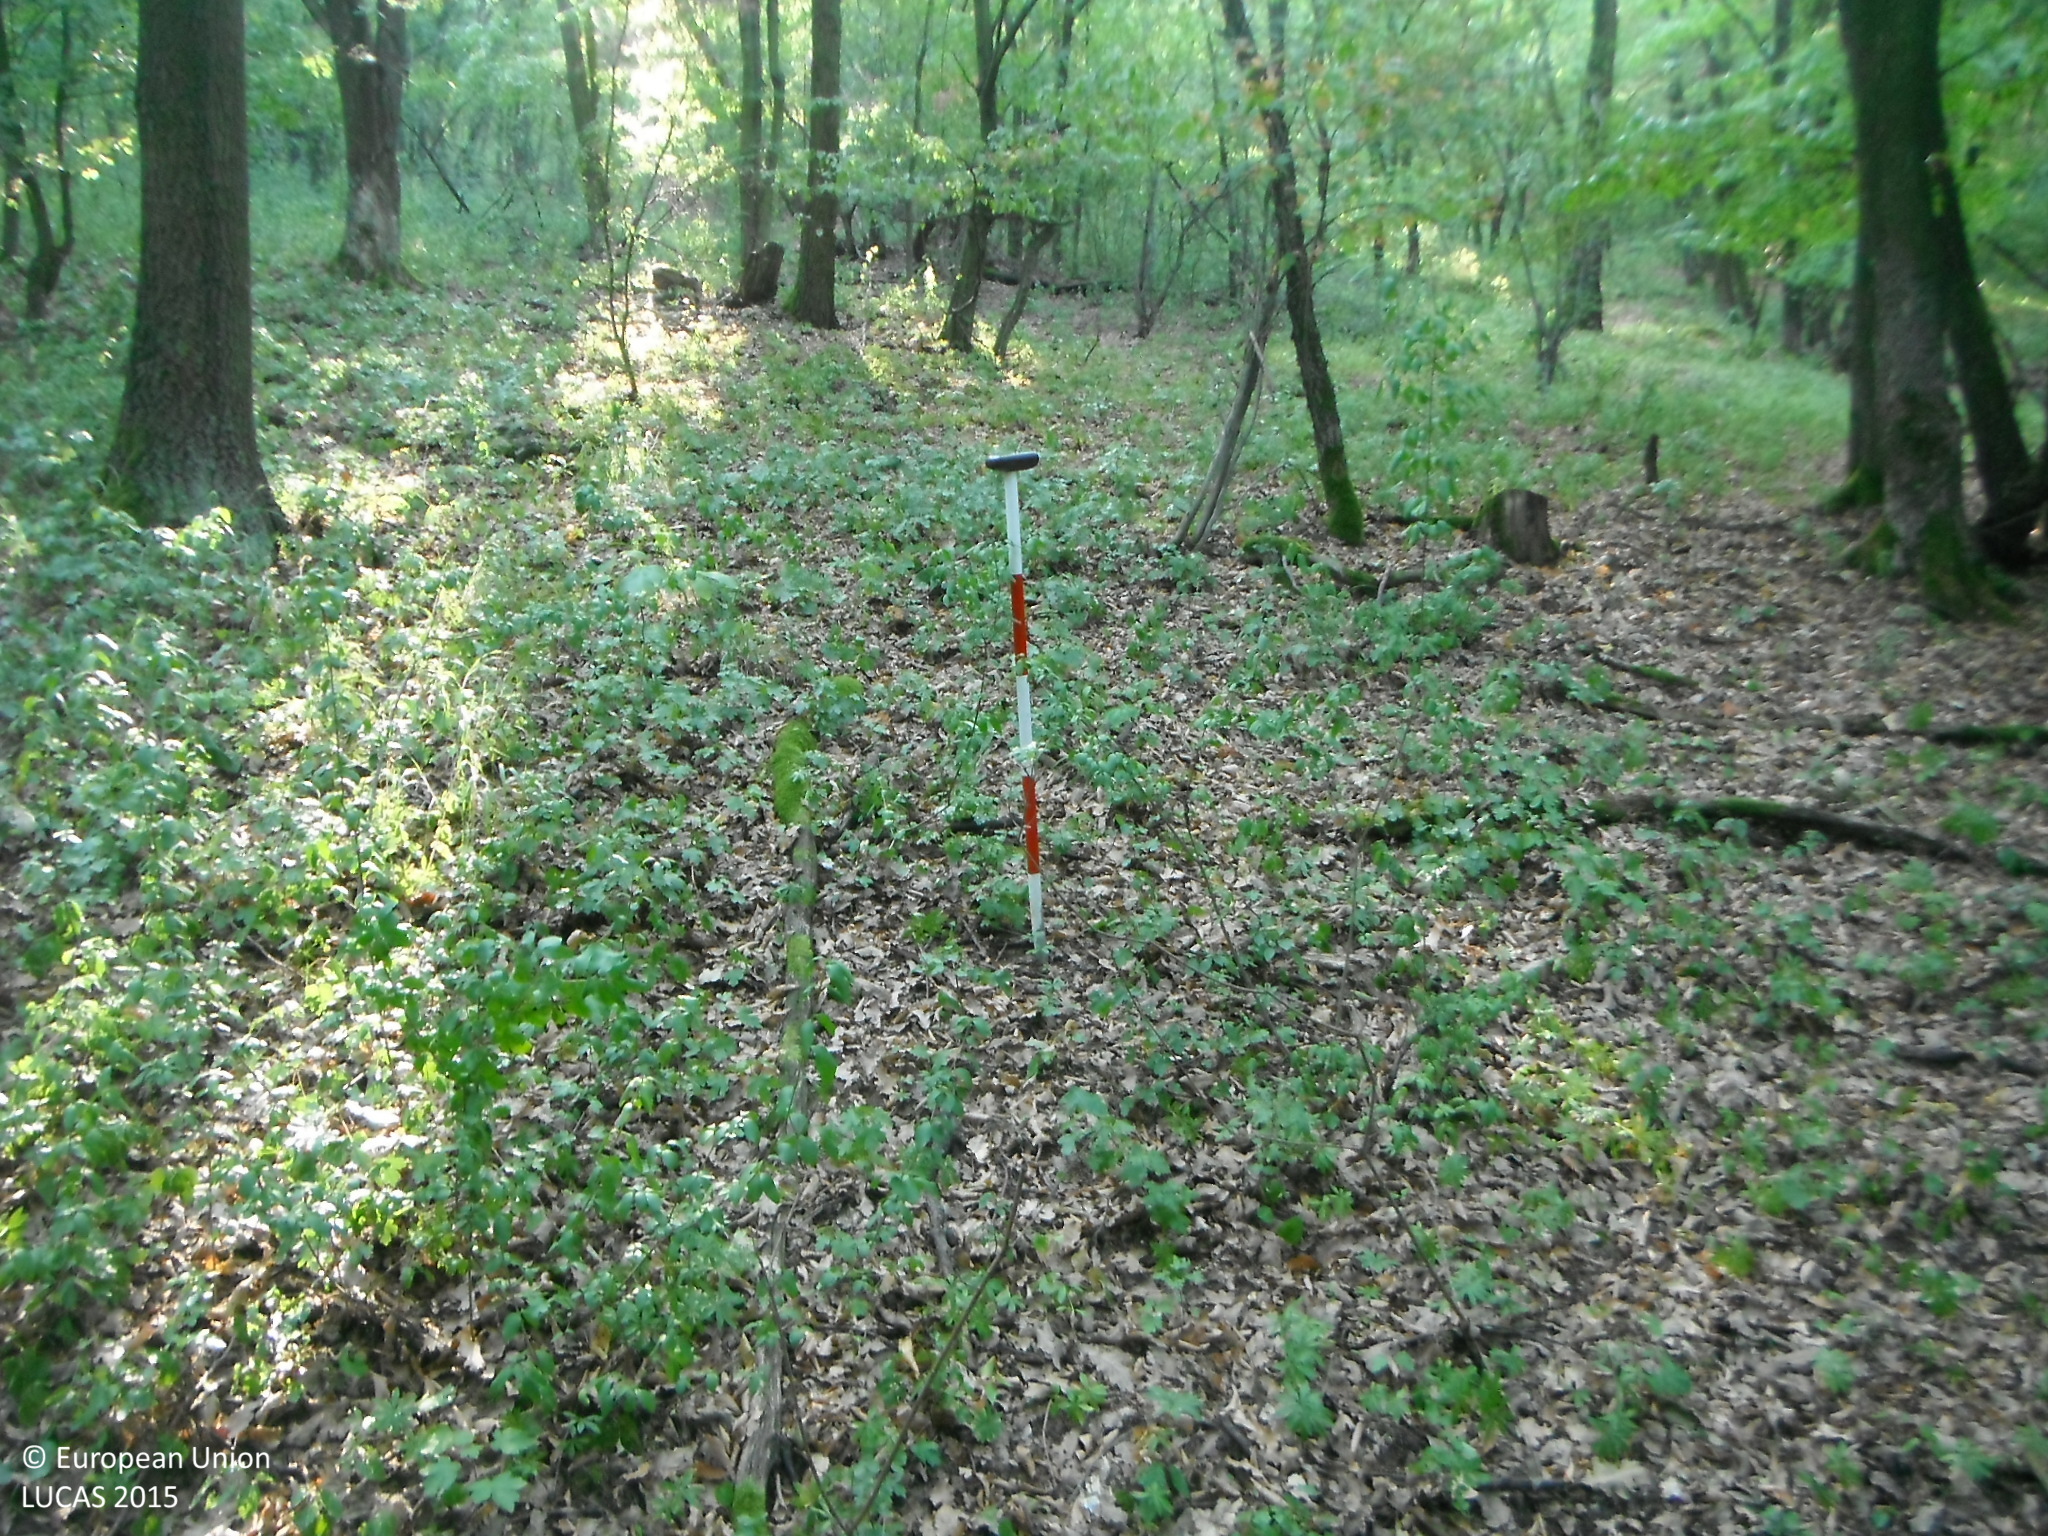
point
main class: Woodland
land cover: Broadleaved woodland
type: mesophytic deciduous forest
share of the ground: > 75 %
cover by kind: broadleaved forest trees 90 %, shrubs 5 %, herbaceous plants 5 %
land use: Forestry
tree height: > 5 m
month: August
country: SK
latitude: 48.5019
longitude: 17.8761
